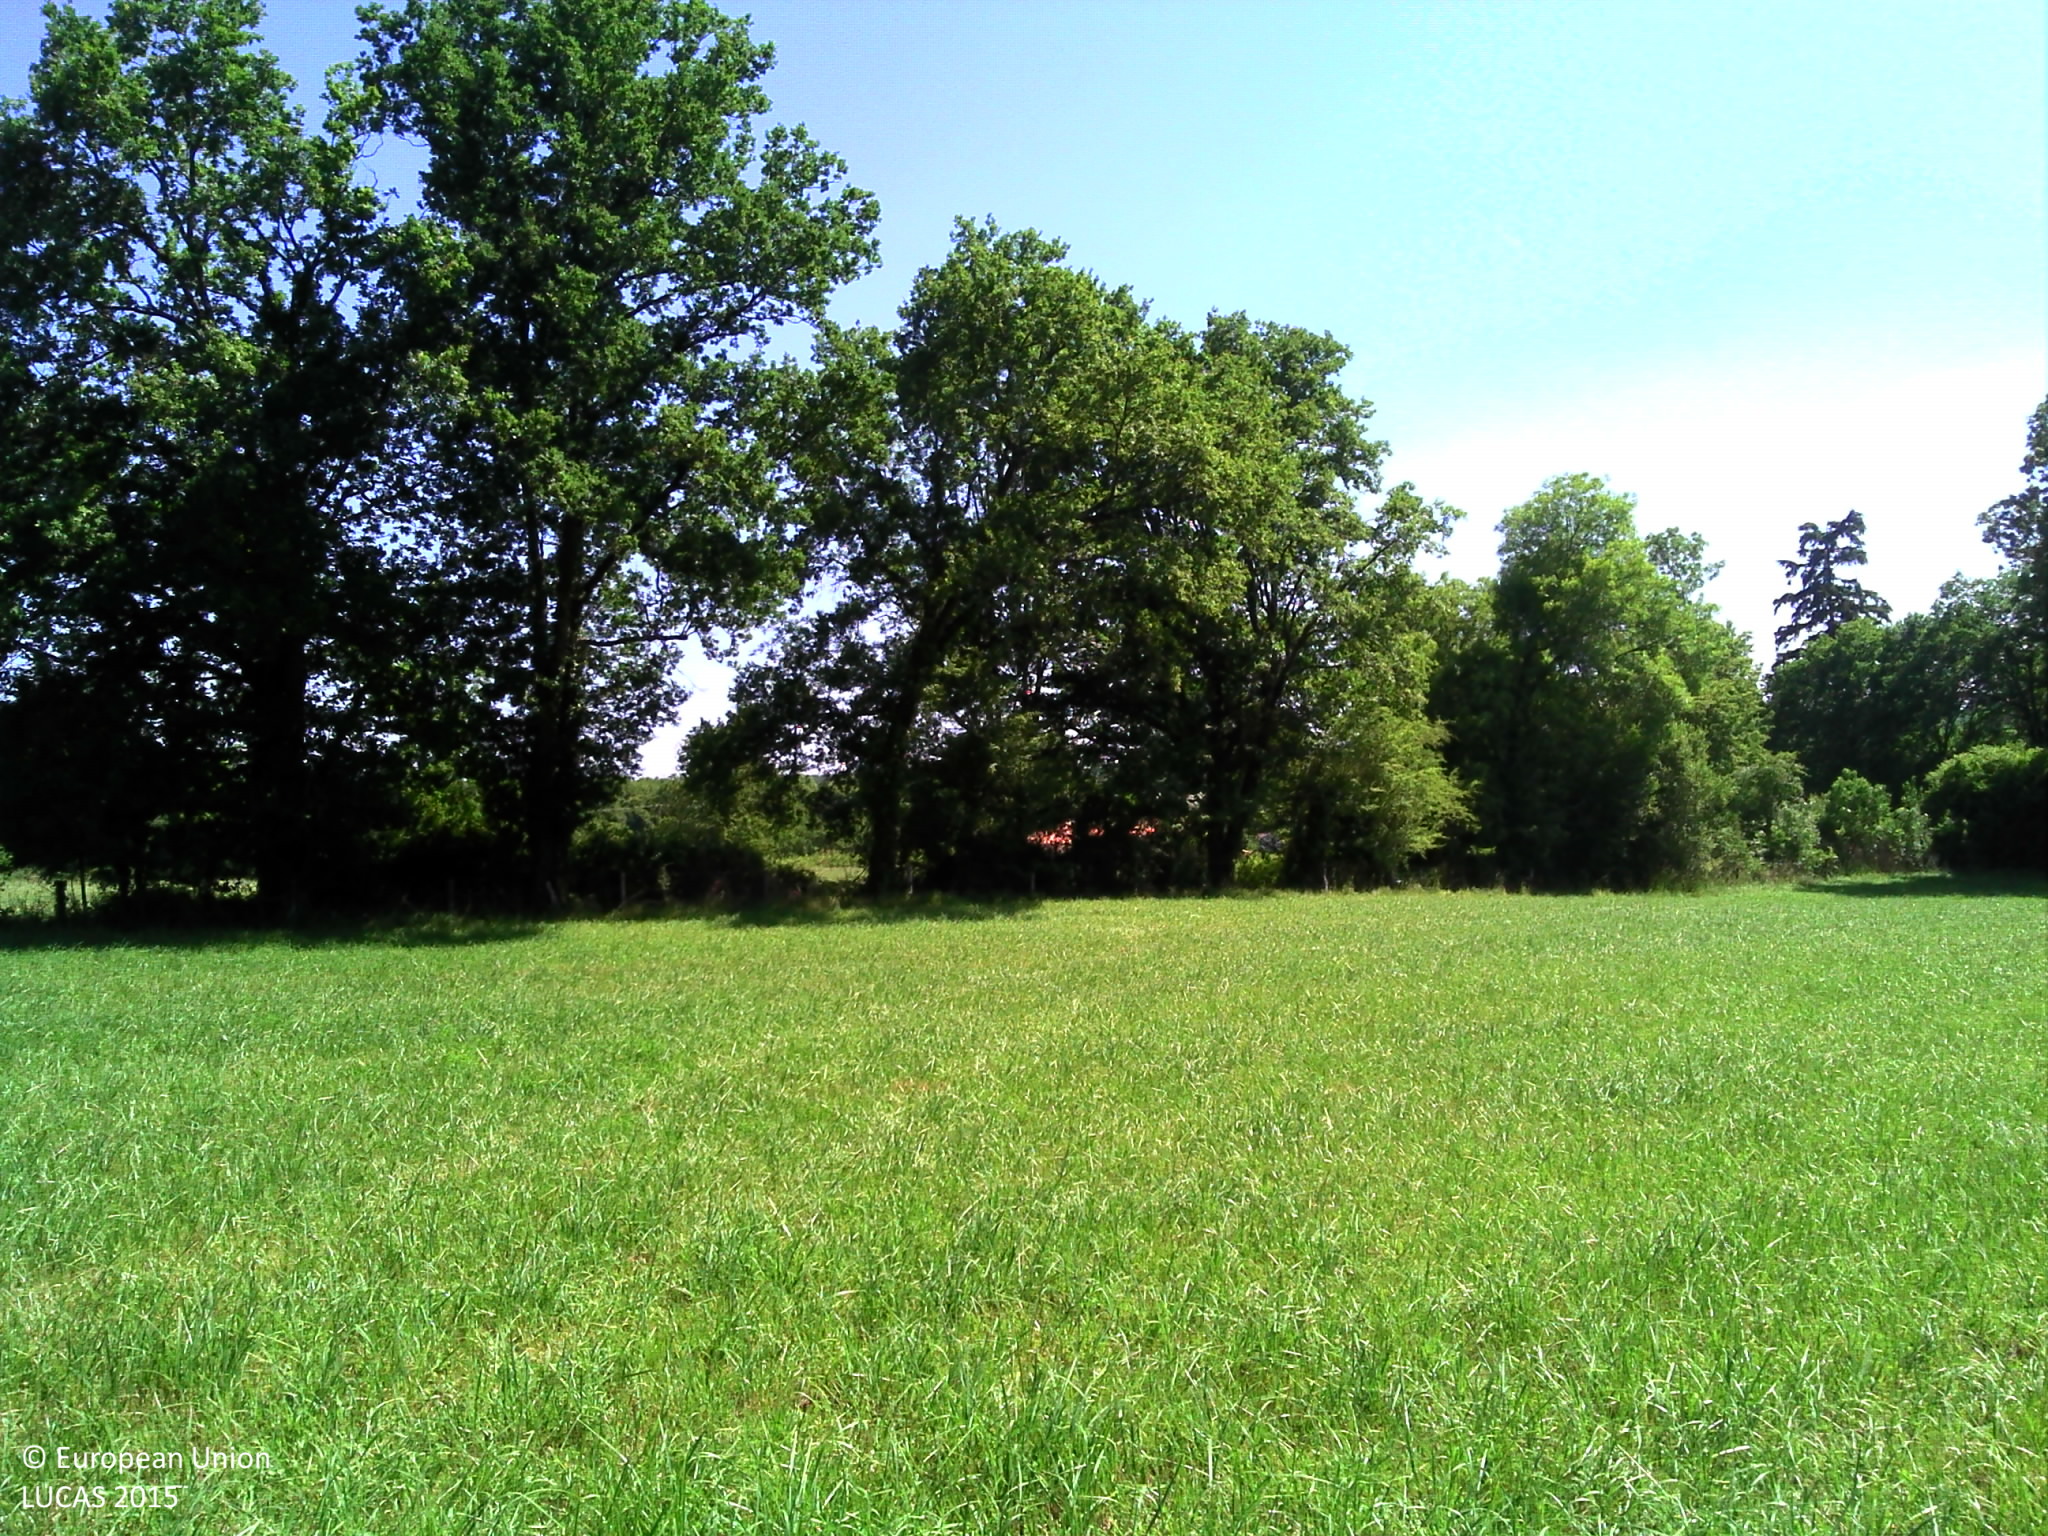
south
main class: Cropland
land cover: Temporary grasslands
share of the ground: > 75 %
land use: Agriculture (excluding fallow land and kitchen gardens)
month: June
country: FR
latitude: 45.9171
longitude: 0.5866
